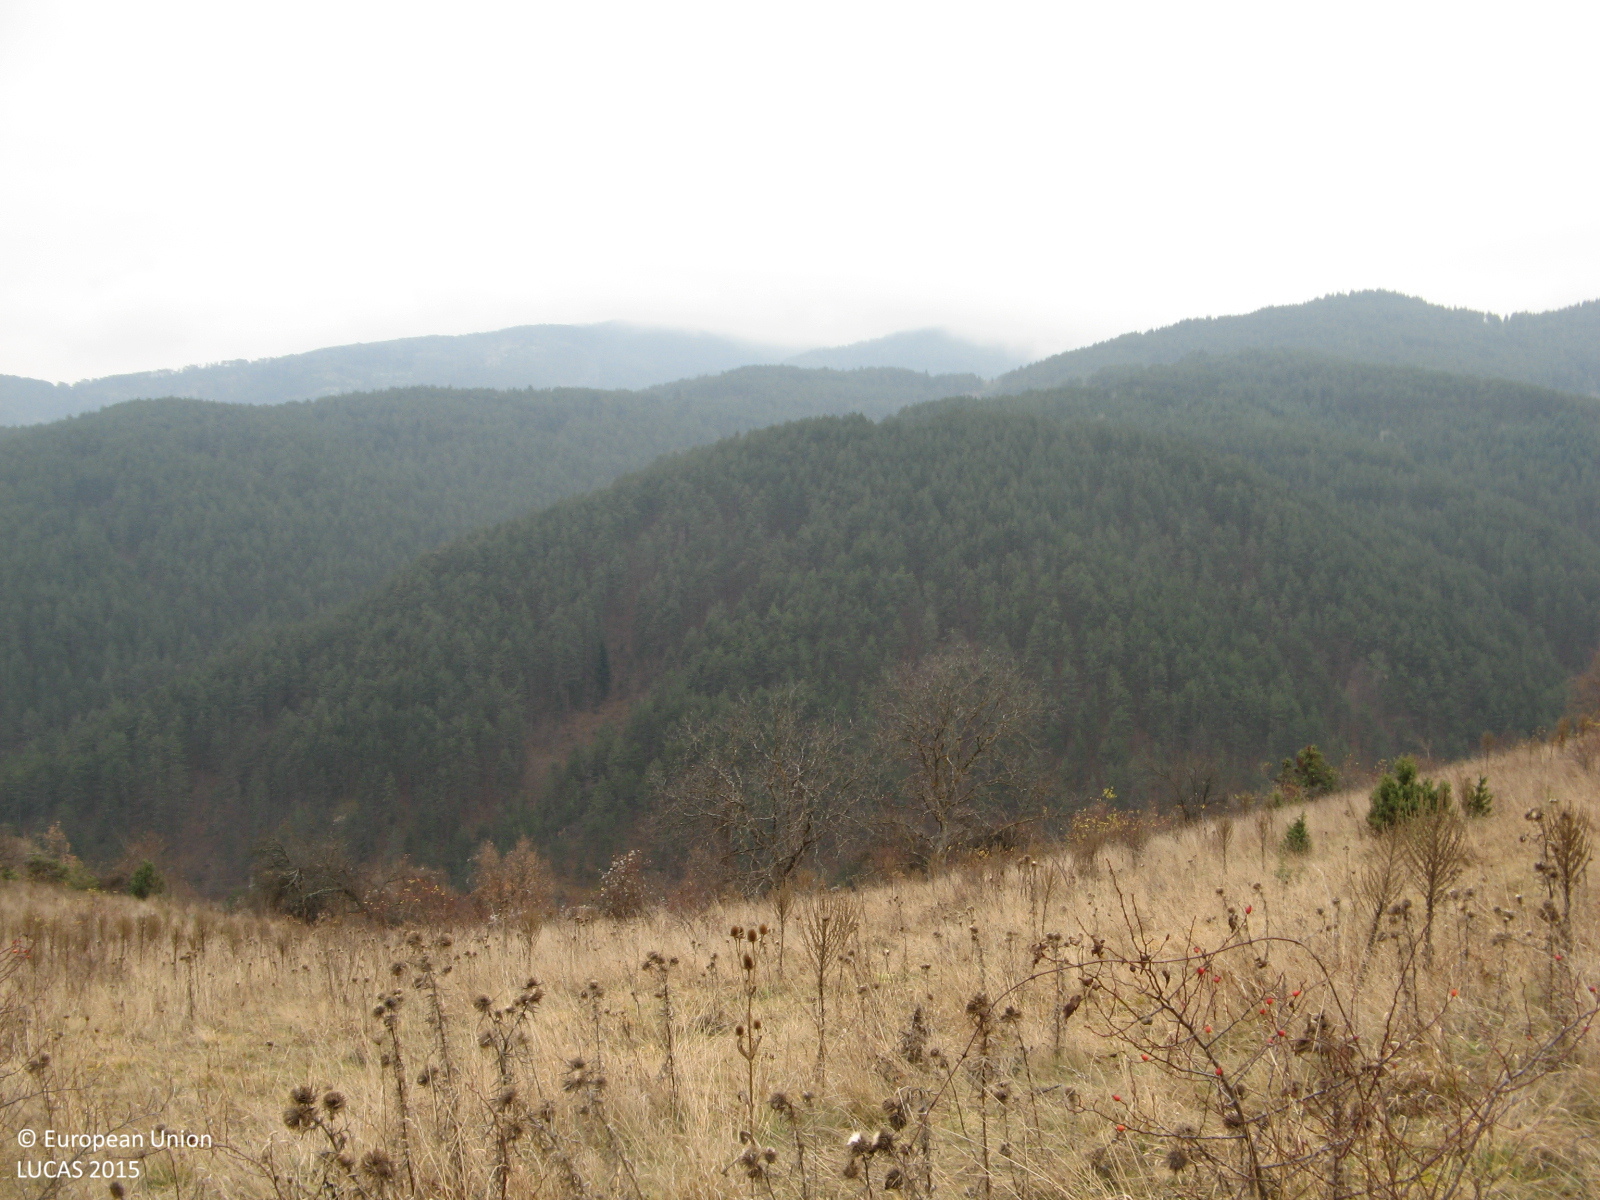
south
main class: Grassland
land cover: Grassland without tree/shrub cover
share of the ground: > 75 %
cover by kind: herbaceous plants 95 %, shrubs 5 %
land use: Agriculture (excluding fallow land and kitchen gardens)
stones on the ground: < 10 %
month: December
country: BG
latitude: 41.8771
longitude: 24.6384
